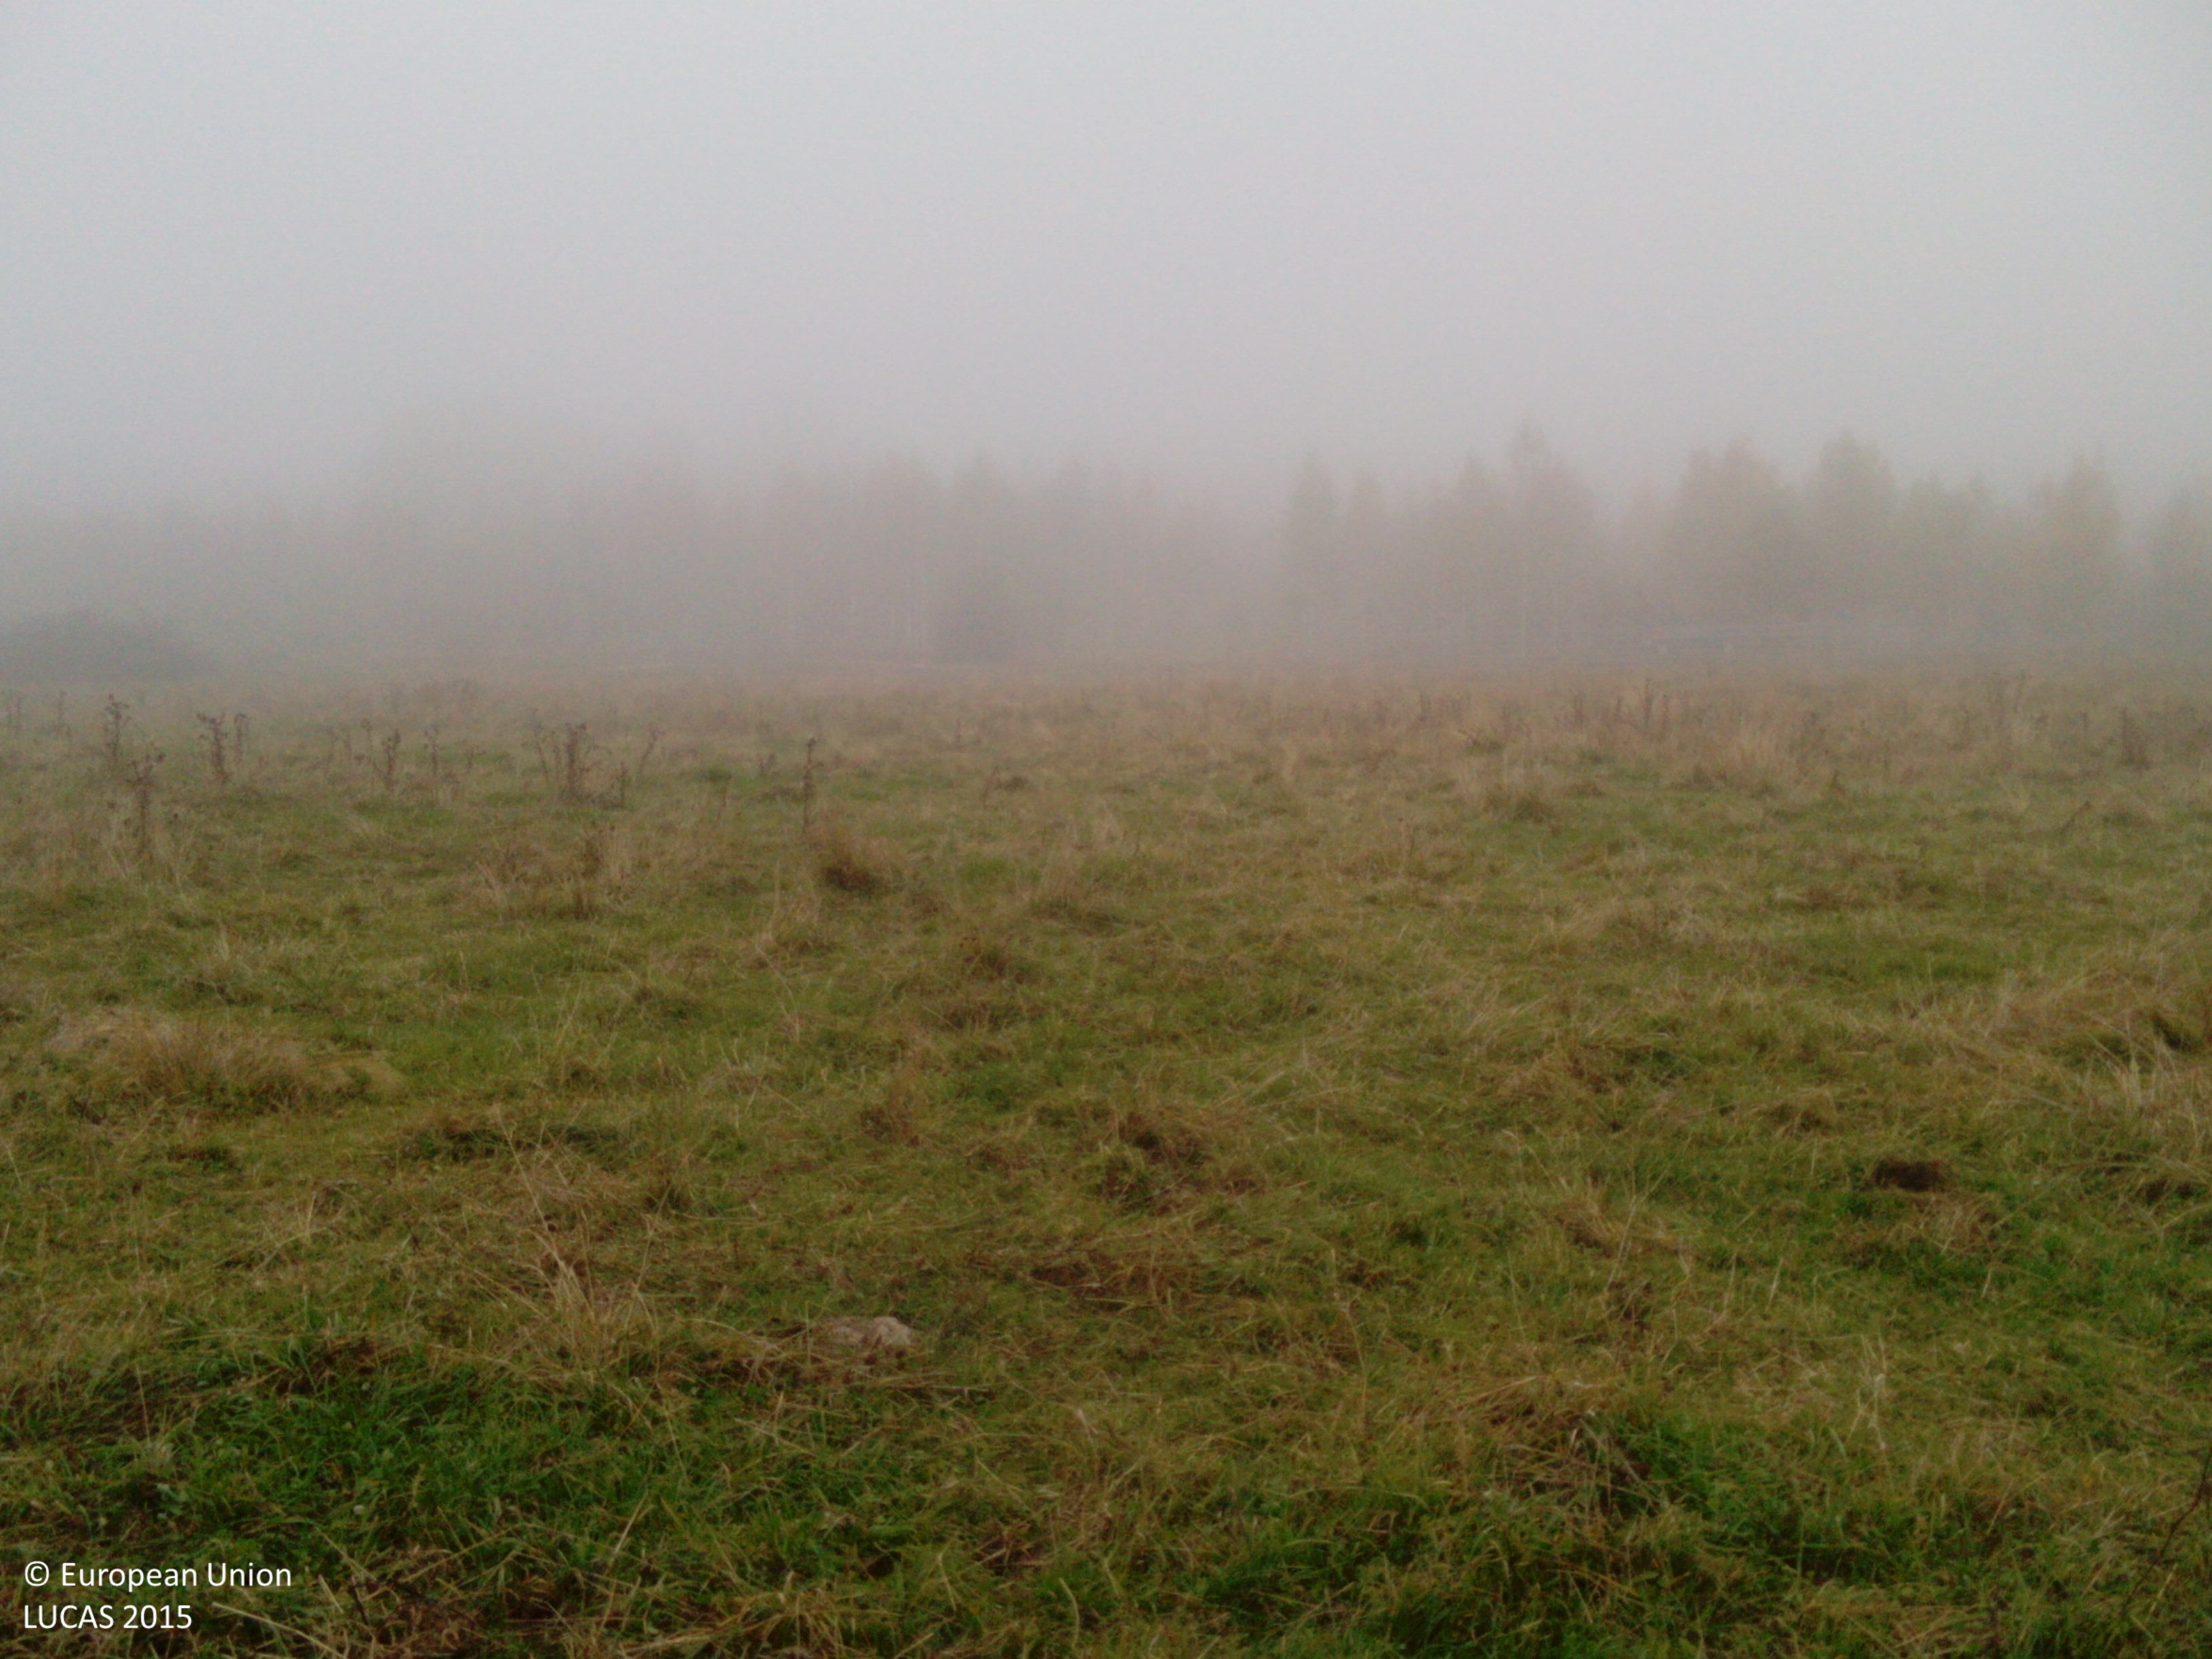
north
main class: Grassland
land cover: Grassland without tree/shrub cover
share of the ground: > 75 %
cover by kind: herbaceous plants 100 %
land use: Agriculture (excluding fallow land and kitchen gardens)
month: October
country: SE
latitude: 58.9301
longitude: 16.4744
